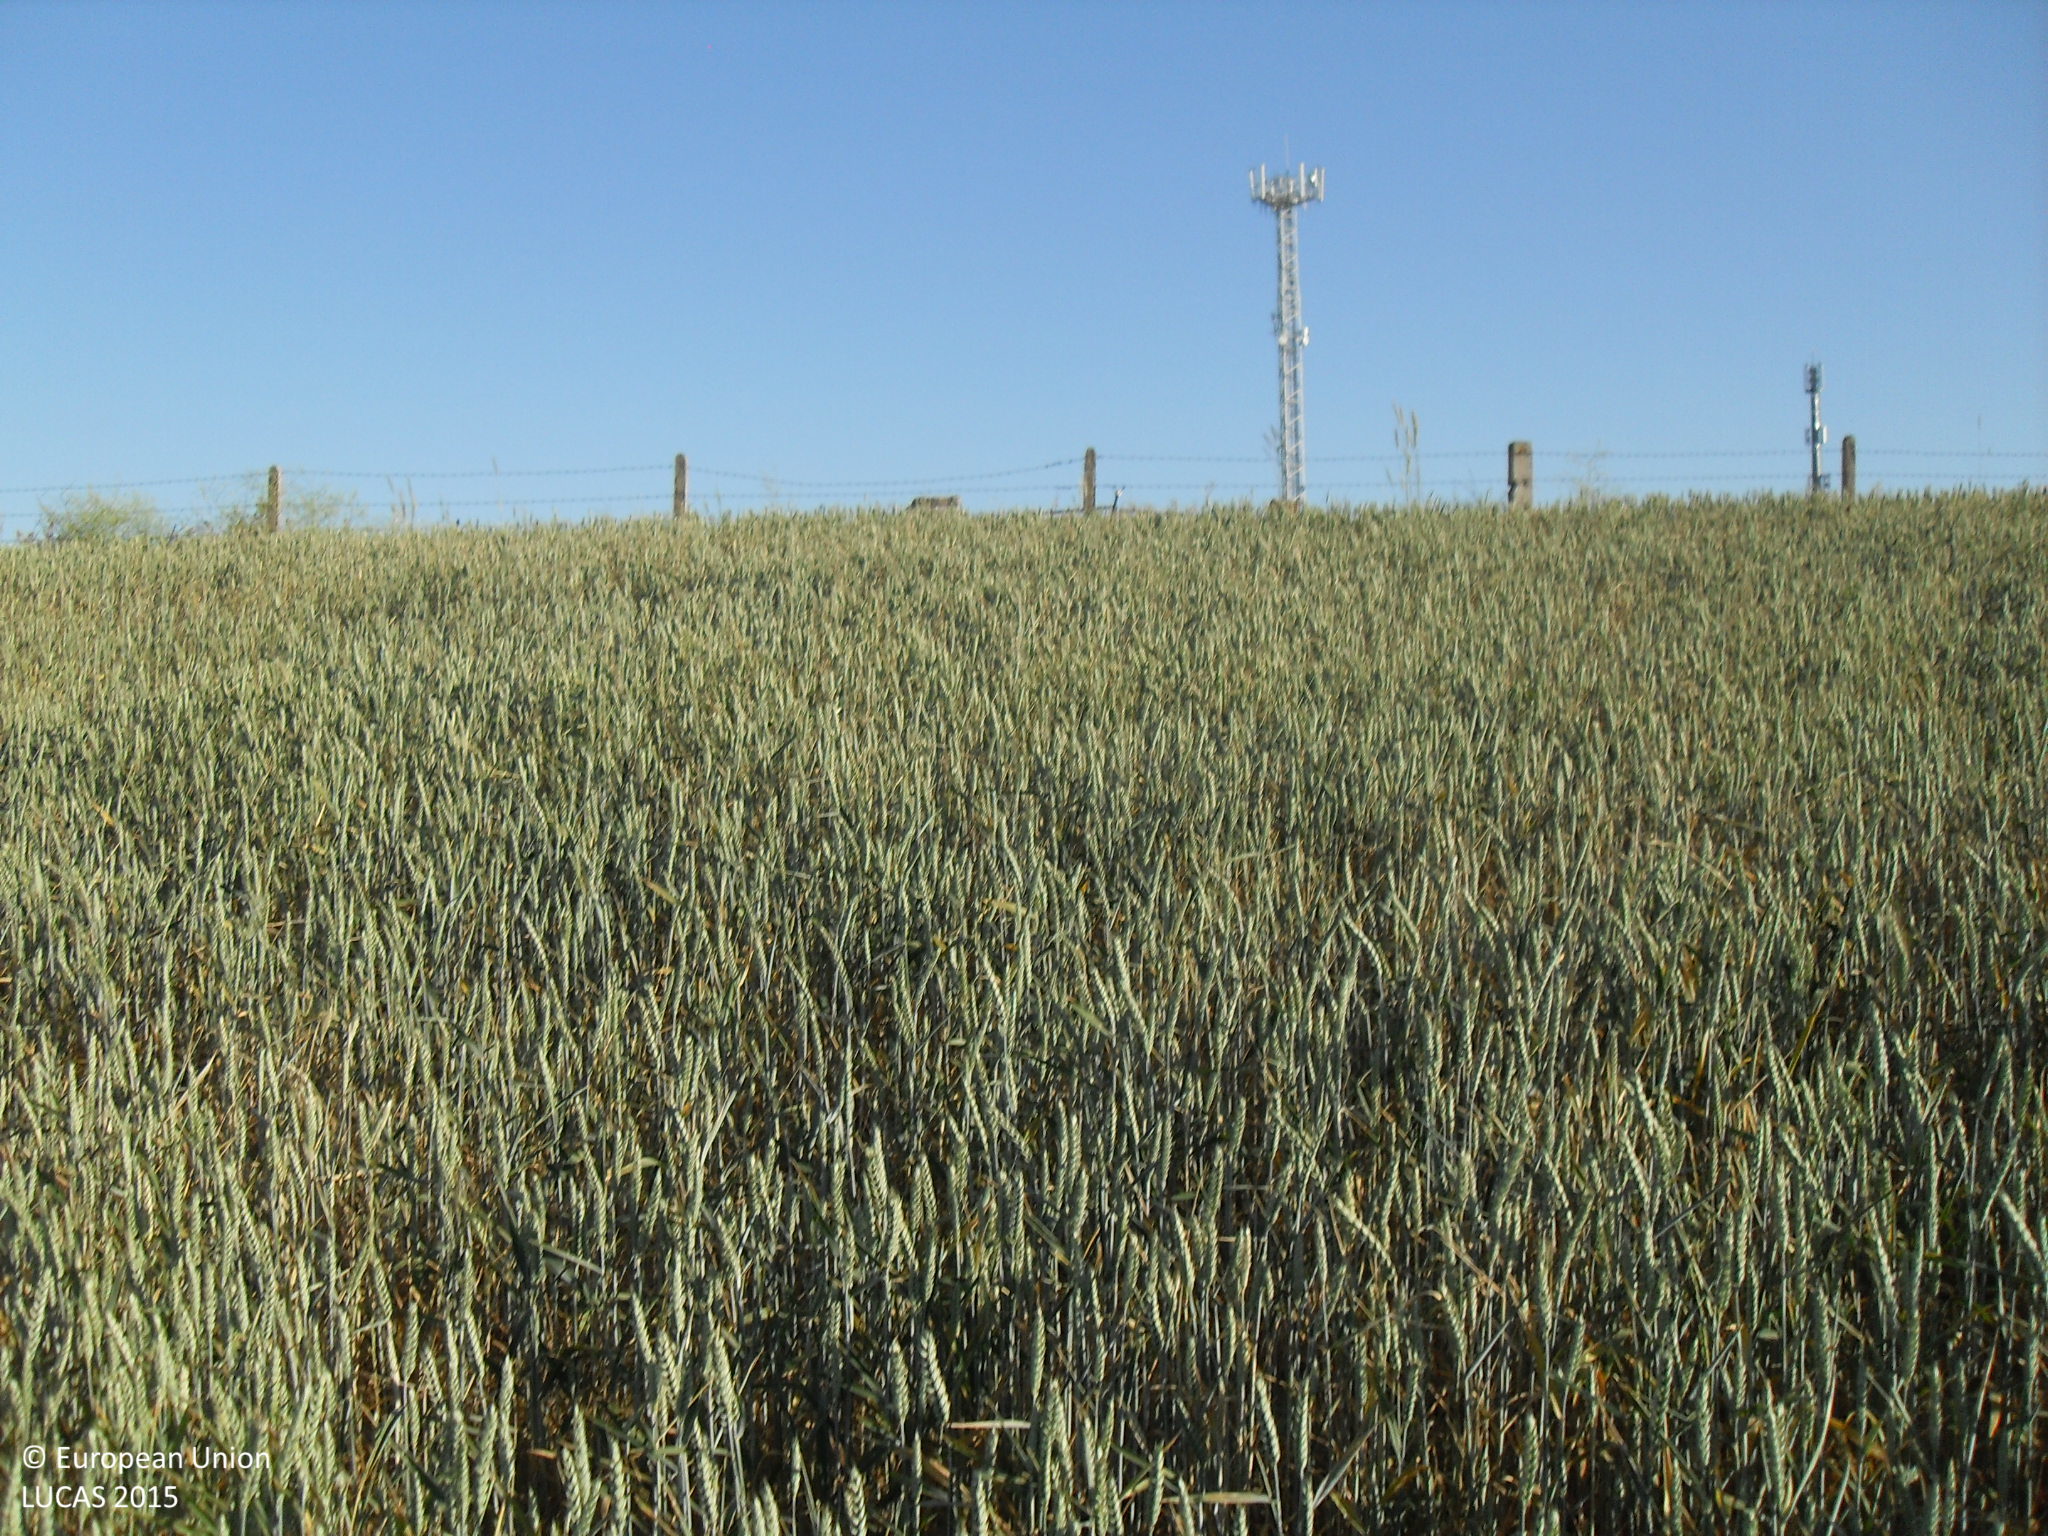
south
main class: Cropland
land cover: Common wheat
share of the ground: > 75 %
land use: Agriculture (excluding fallow land and kitchen gardens)
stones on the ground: < 10 %
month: June
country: ES
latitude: 40.5411
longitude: -5.5718
